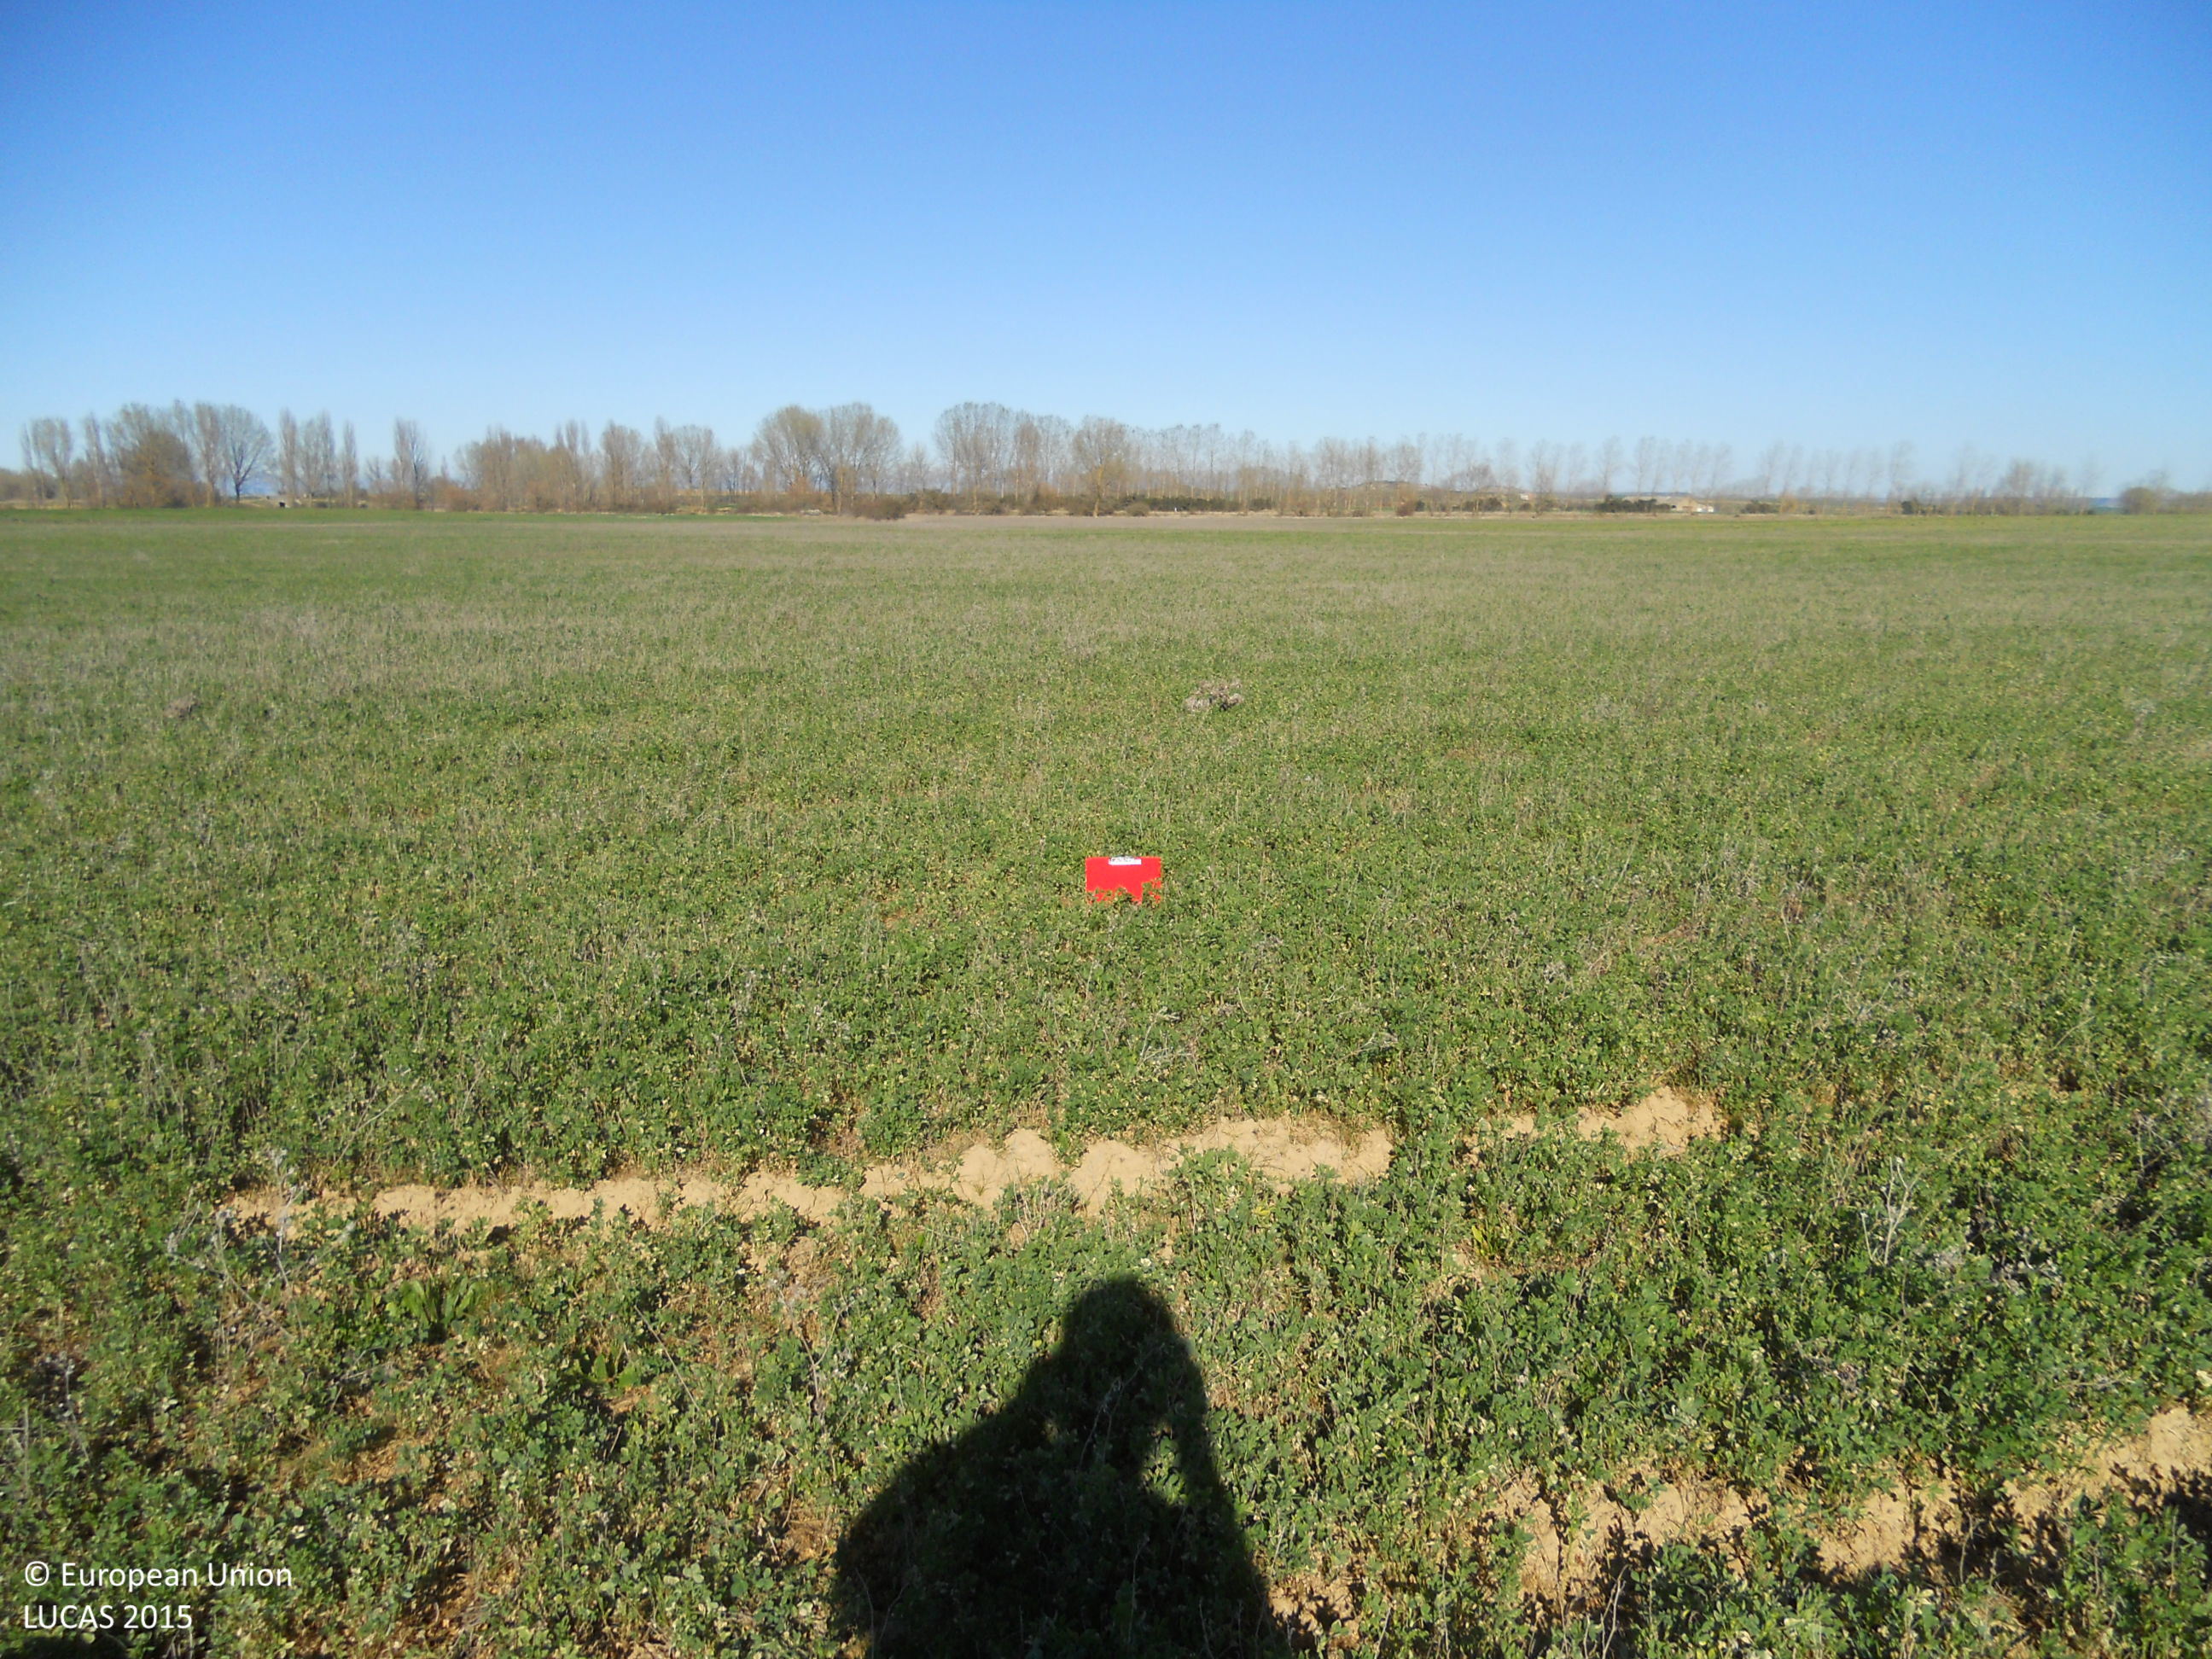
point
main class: Cropland
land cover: Lucerne
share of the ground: > 75 %
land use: Agriculture (excluding fallow land and kitchen gardens)
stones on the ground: < 10 %
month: April
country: ES
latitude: 42.2652
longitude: -4.3636
